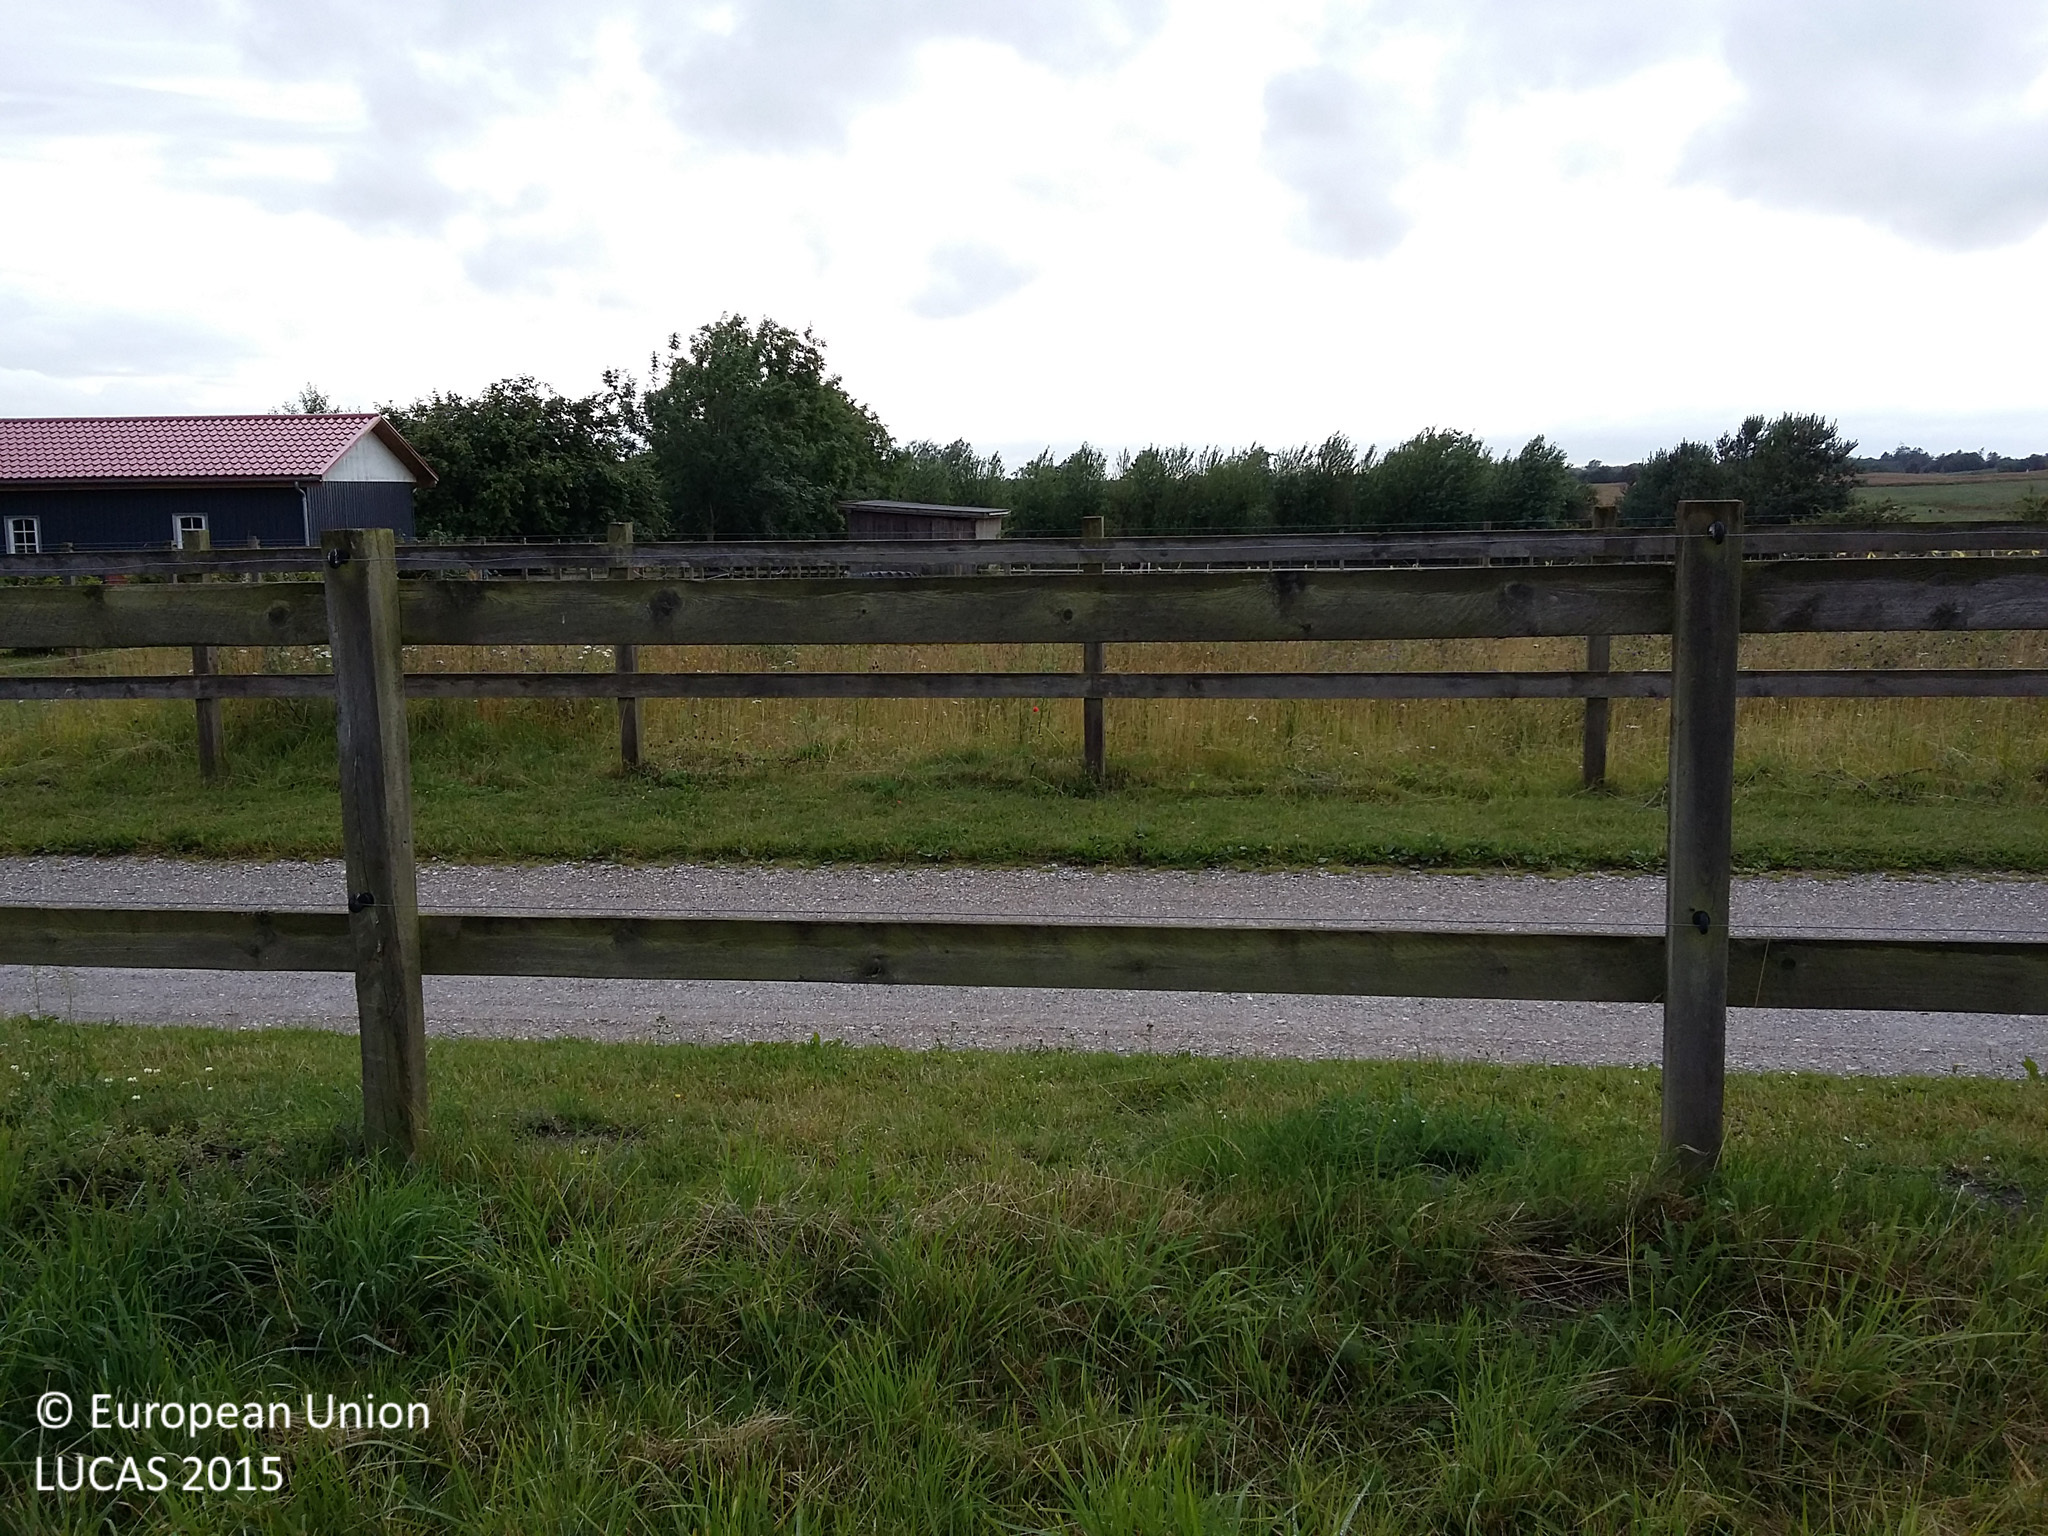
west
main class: Grassland
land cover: Grassland without tree/shrub cover
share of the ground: > 75 %
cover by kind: herbaceous plants 100 %
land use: Agriculture (excluding fallow land and kitchen gardens)
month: July
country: DK
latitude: 55.8280
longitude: 12.1532
